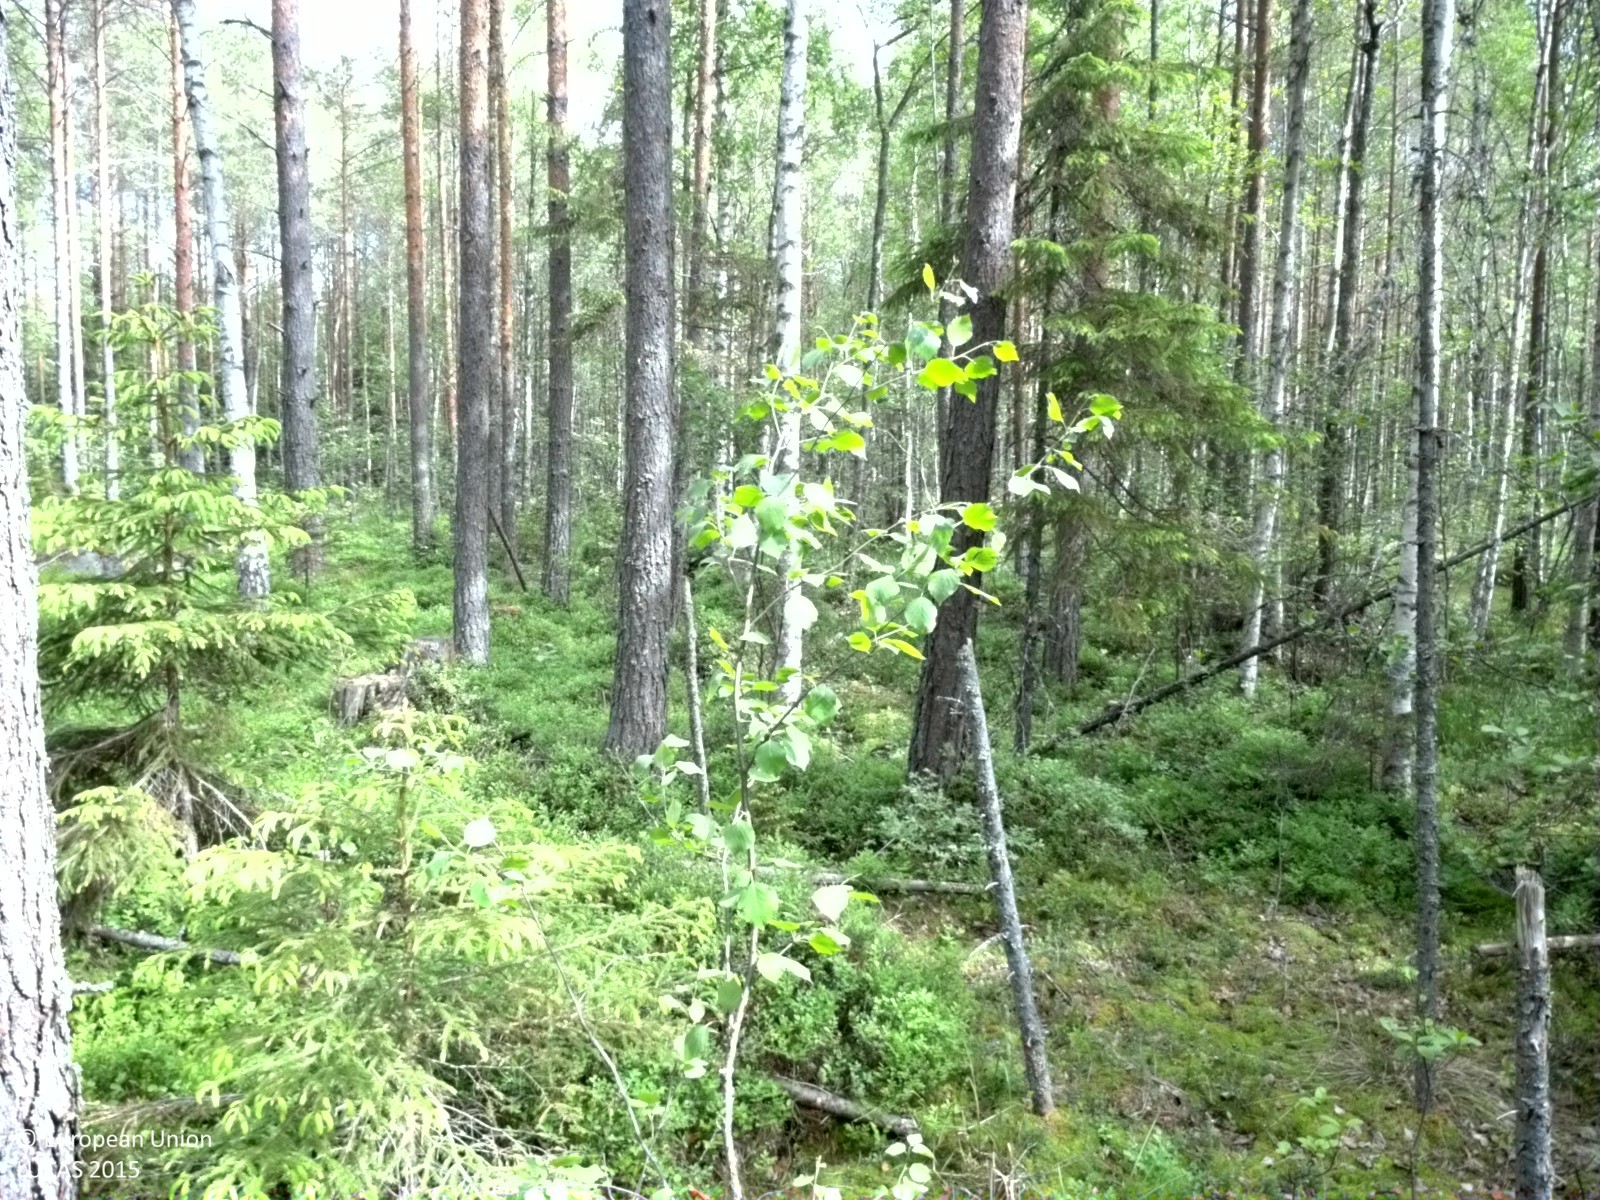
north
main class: Woodland
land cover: Pine dominated coniferous woodland
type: boreal forest
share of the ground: 50 - 75 %
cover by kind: coniferous forest trees 65 %, shrubs 15 %, herbaceous plants 10 %, broadleaved forest trees 5 %, lichens and mosses 5 %
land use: Forestry
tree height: > 5 m
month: June
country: SE
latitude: 60.2839
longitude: 17.2433
